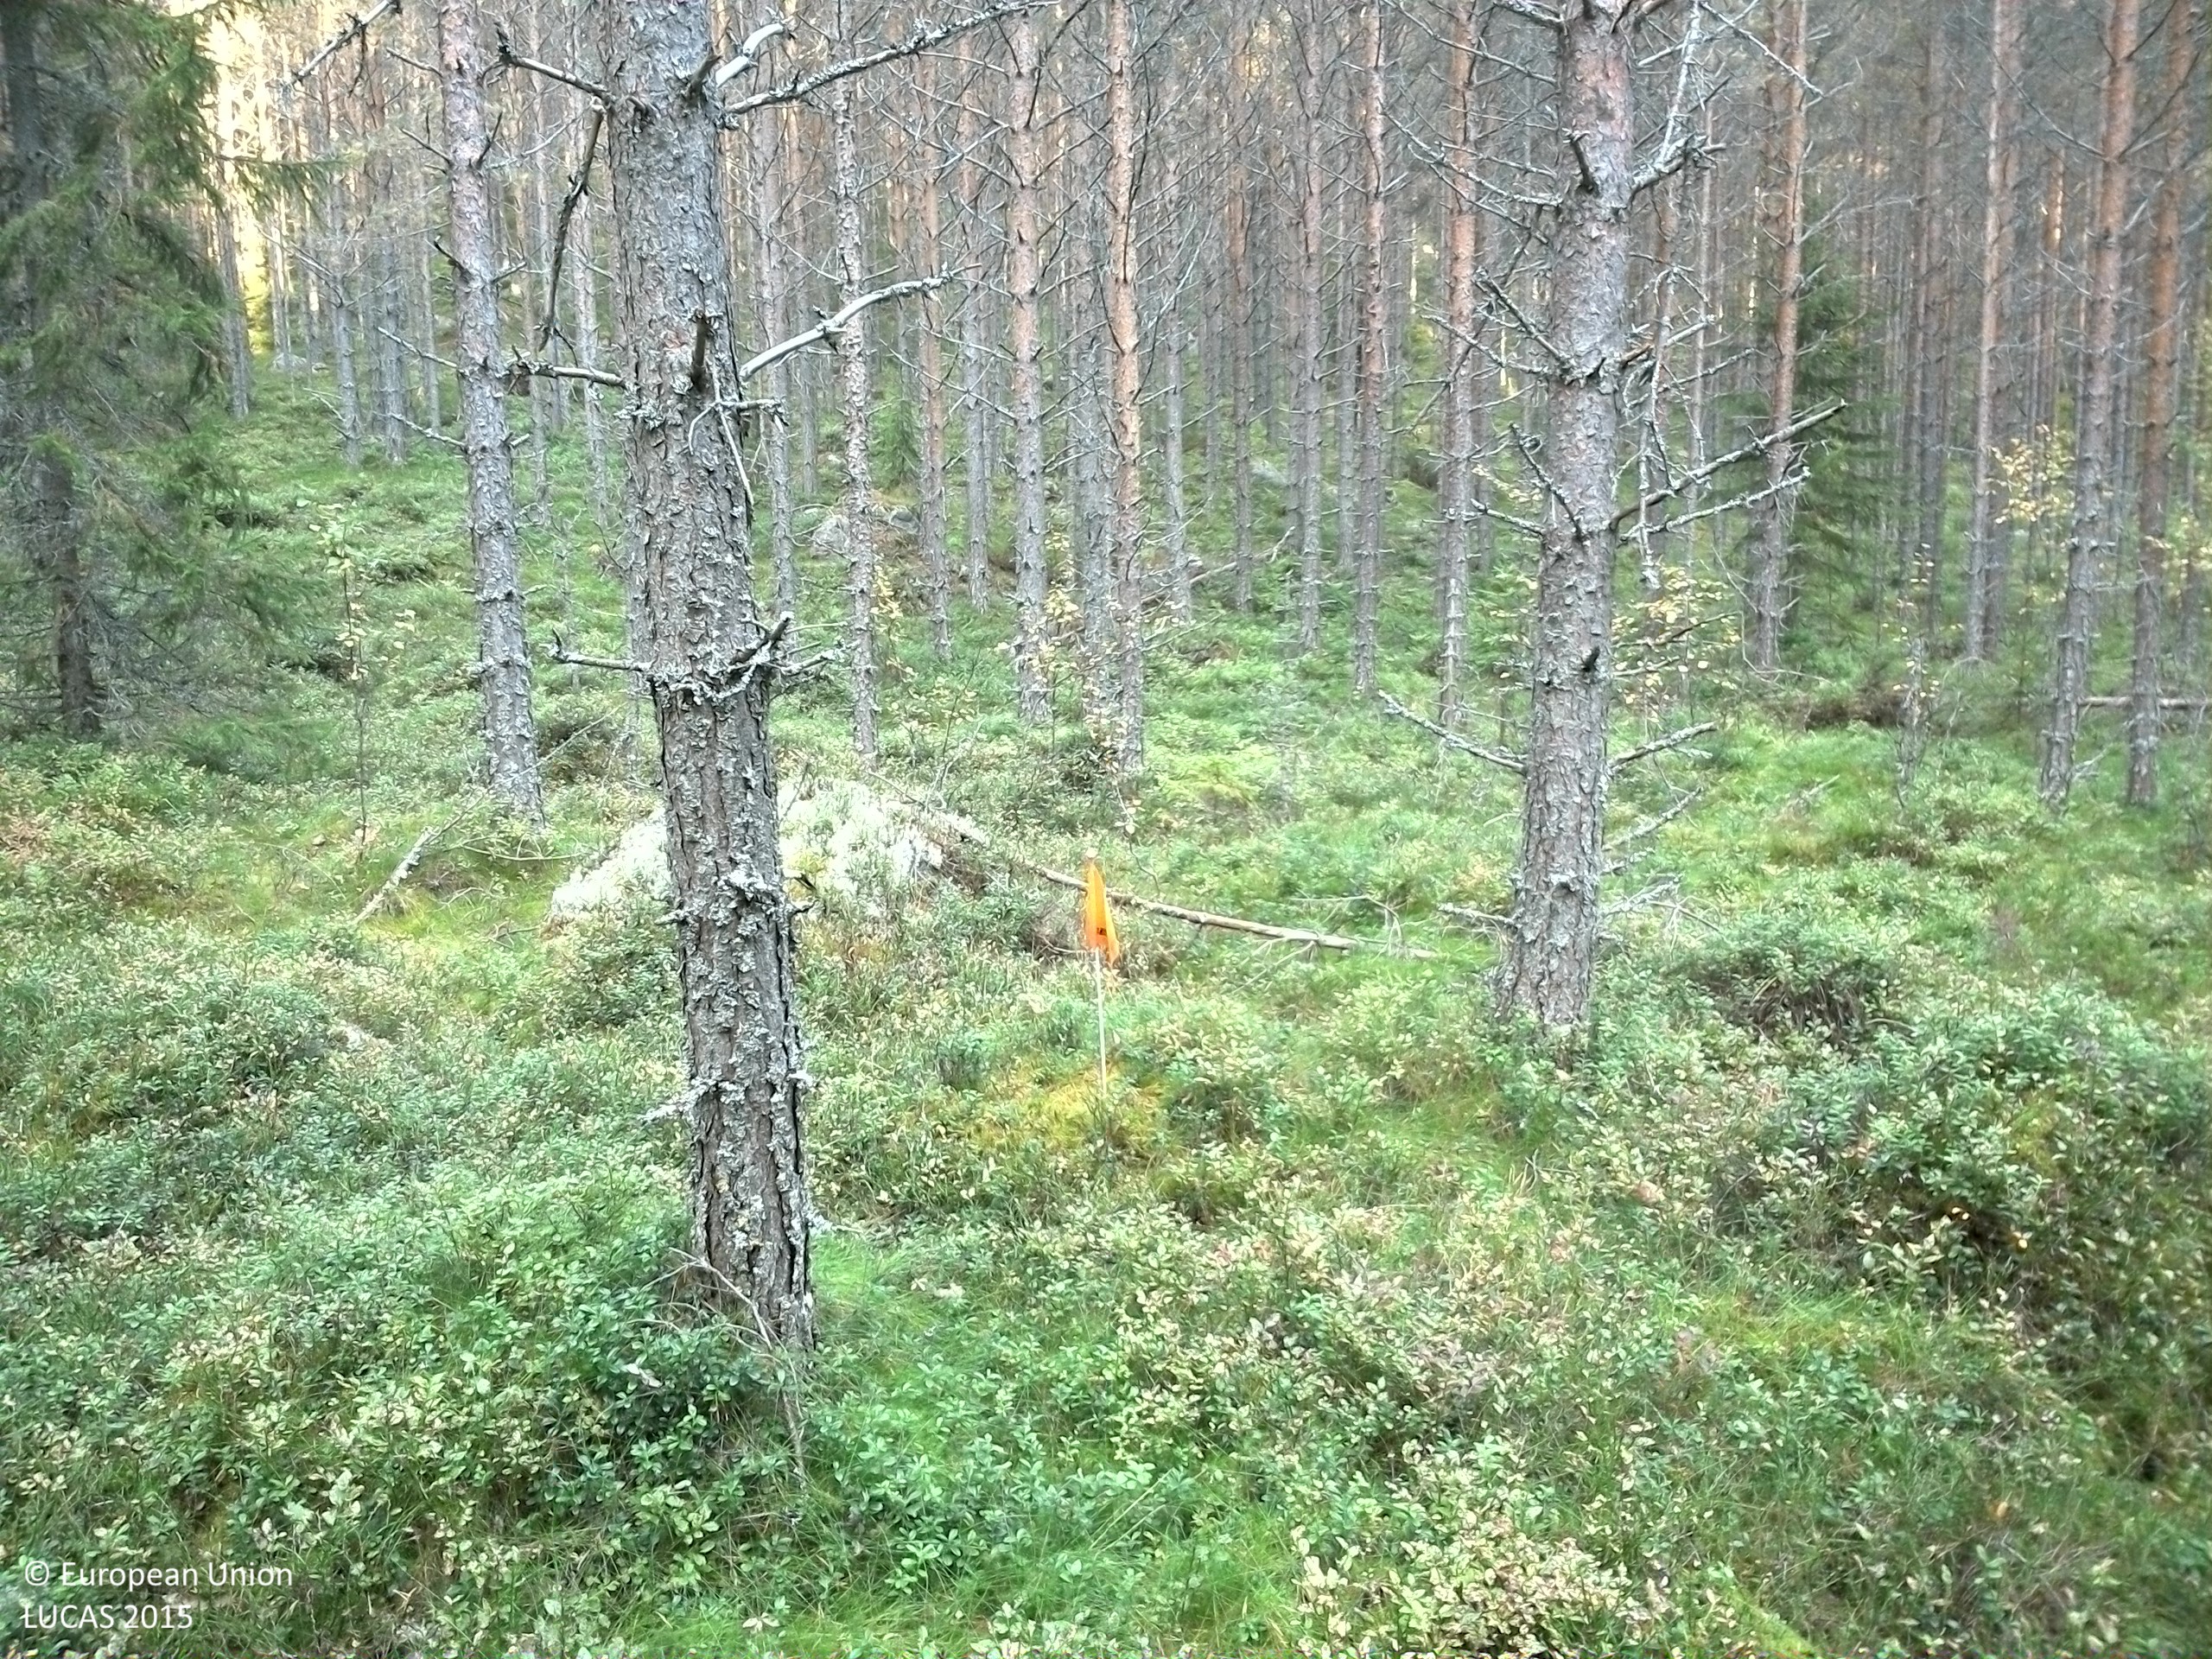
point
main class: Woodland
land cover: Pine dominated coniferous woodland
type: boreal forest
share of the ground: 50 - 75 %
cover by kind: coniferous forest trees 60 %, shrubs 25 %, lichens and mosses 15 %
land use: Forestry
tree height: > 5 m
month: September
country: SE
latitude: 61.3030
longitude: 15.4547
